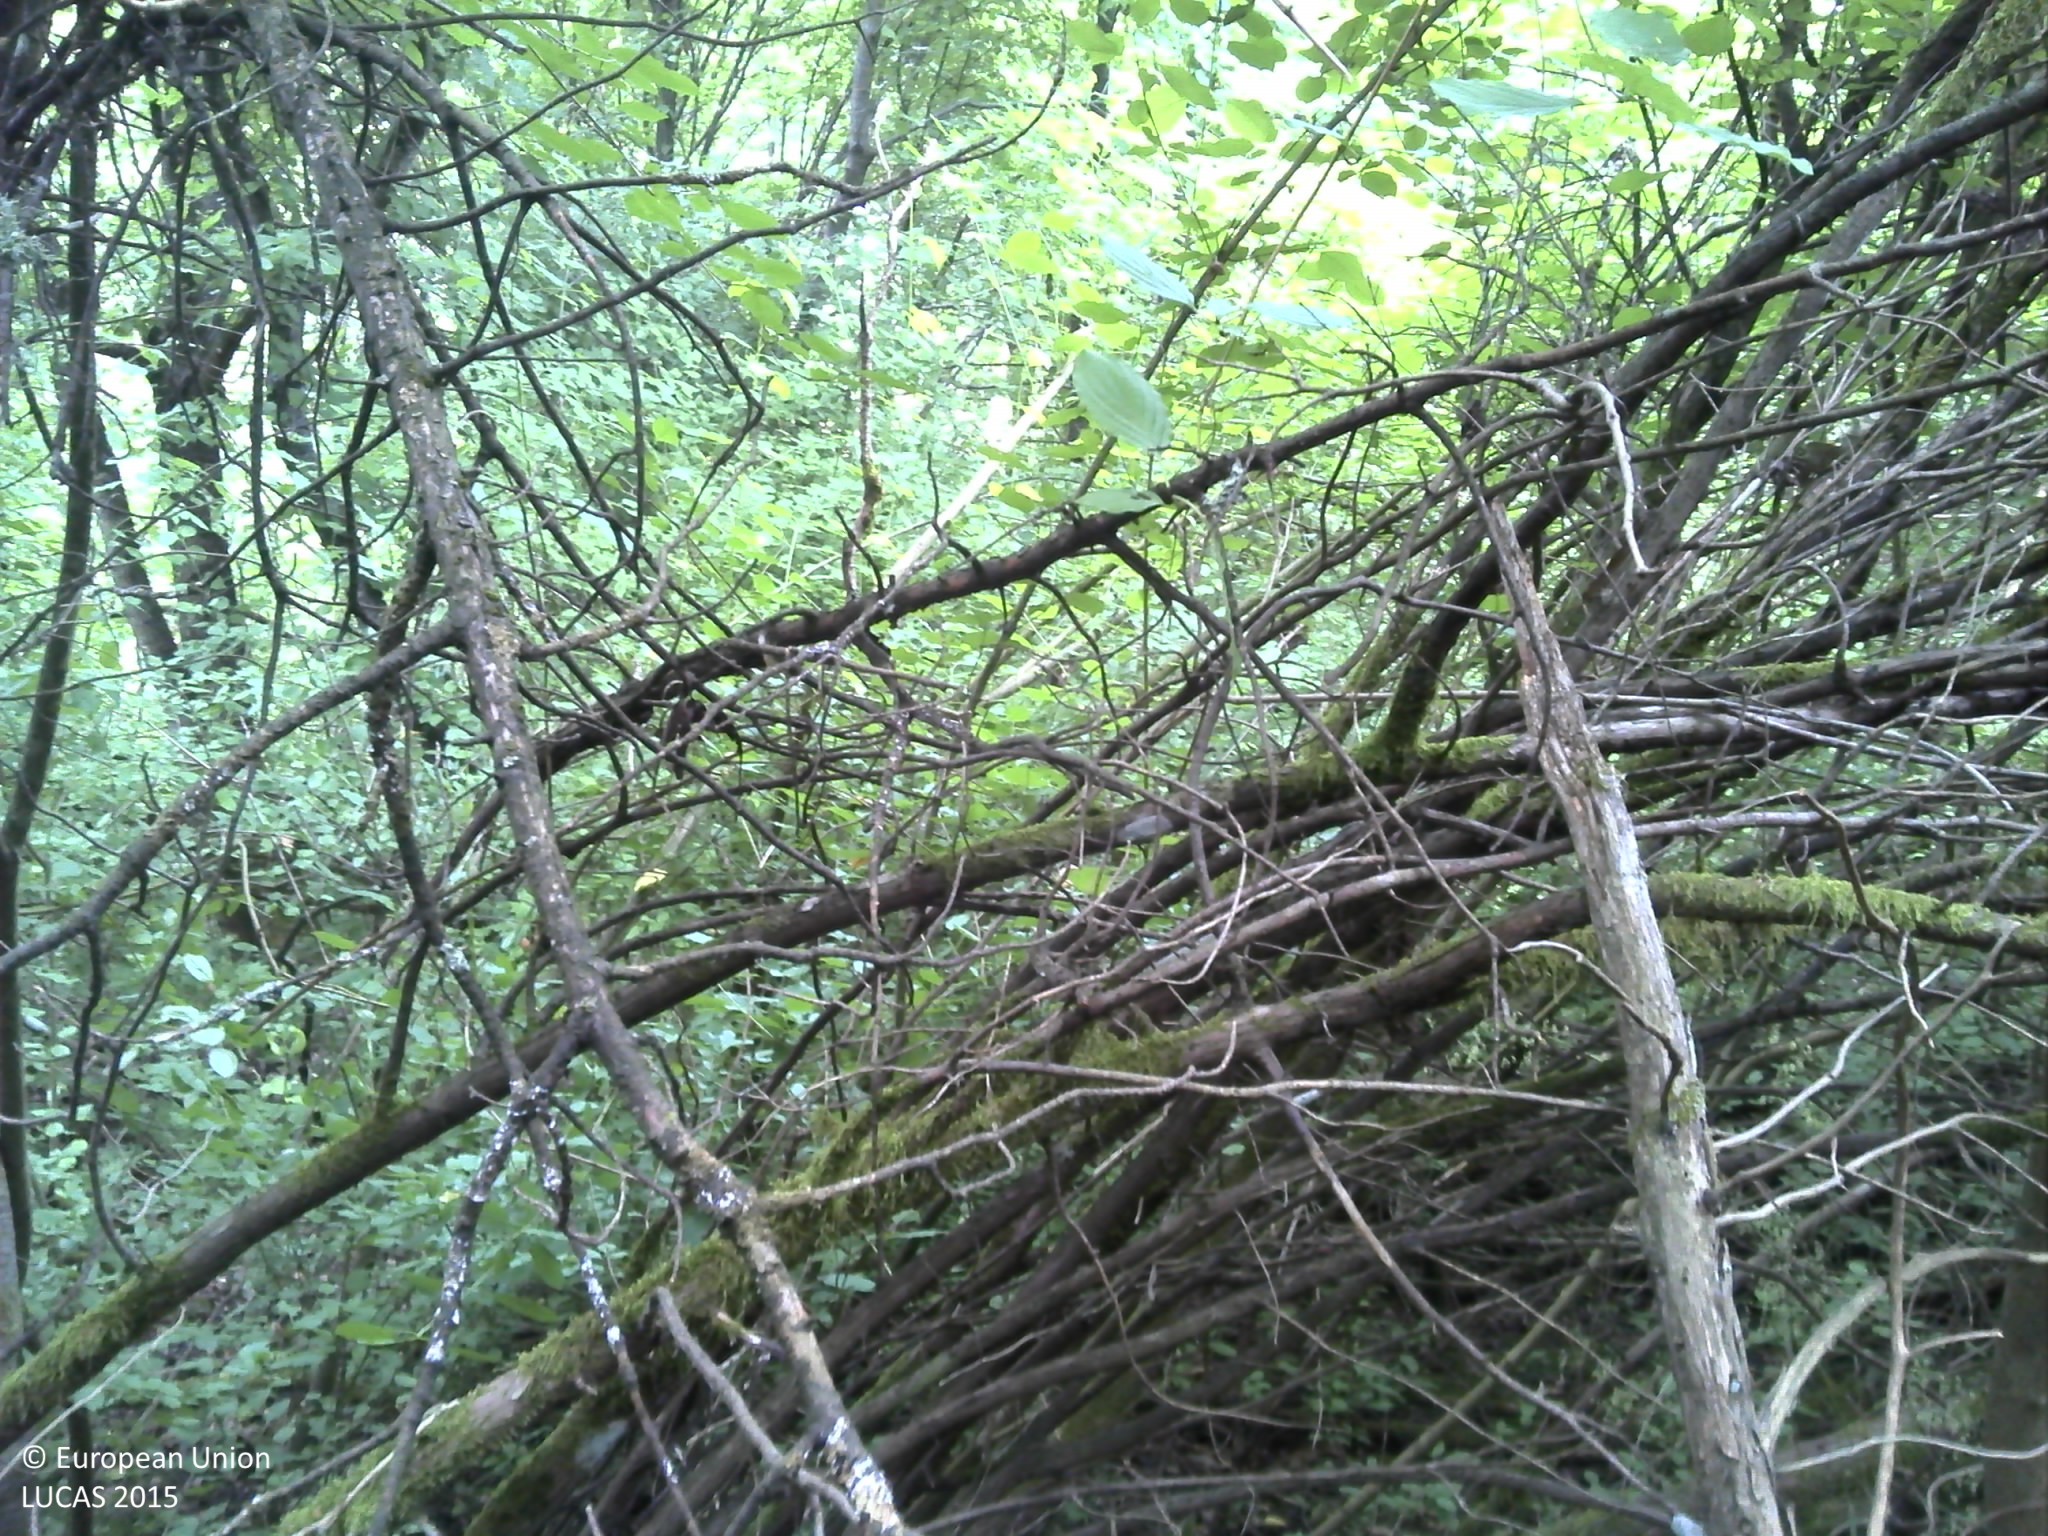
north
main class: Woodland
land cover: Broadleaved woodland
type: beech forest
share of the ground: > 75 %
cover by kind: broadleaved forest trees 100 %
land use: Forestry
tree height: > 5 m
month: June
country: HR
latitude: 45.3841
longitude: 17.4723
